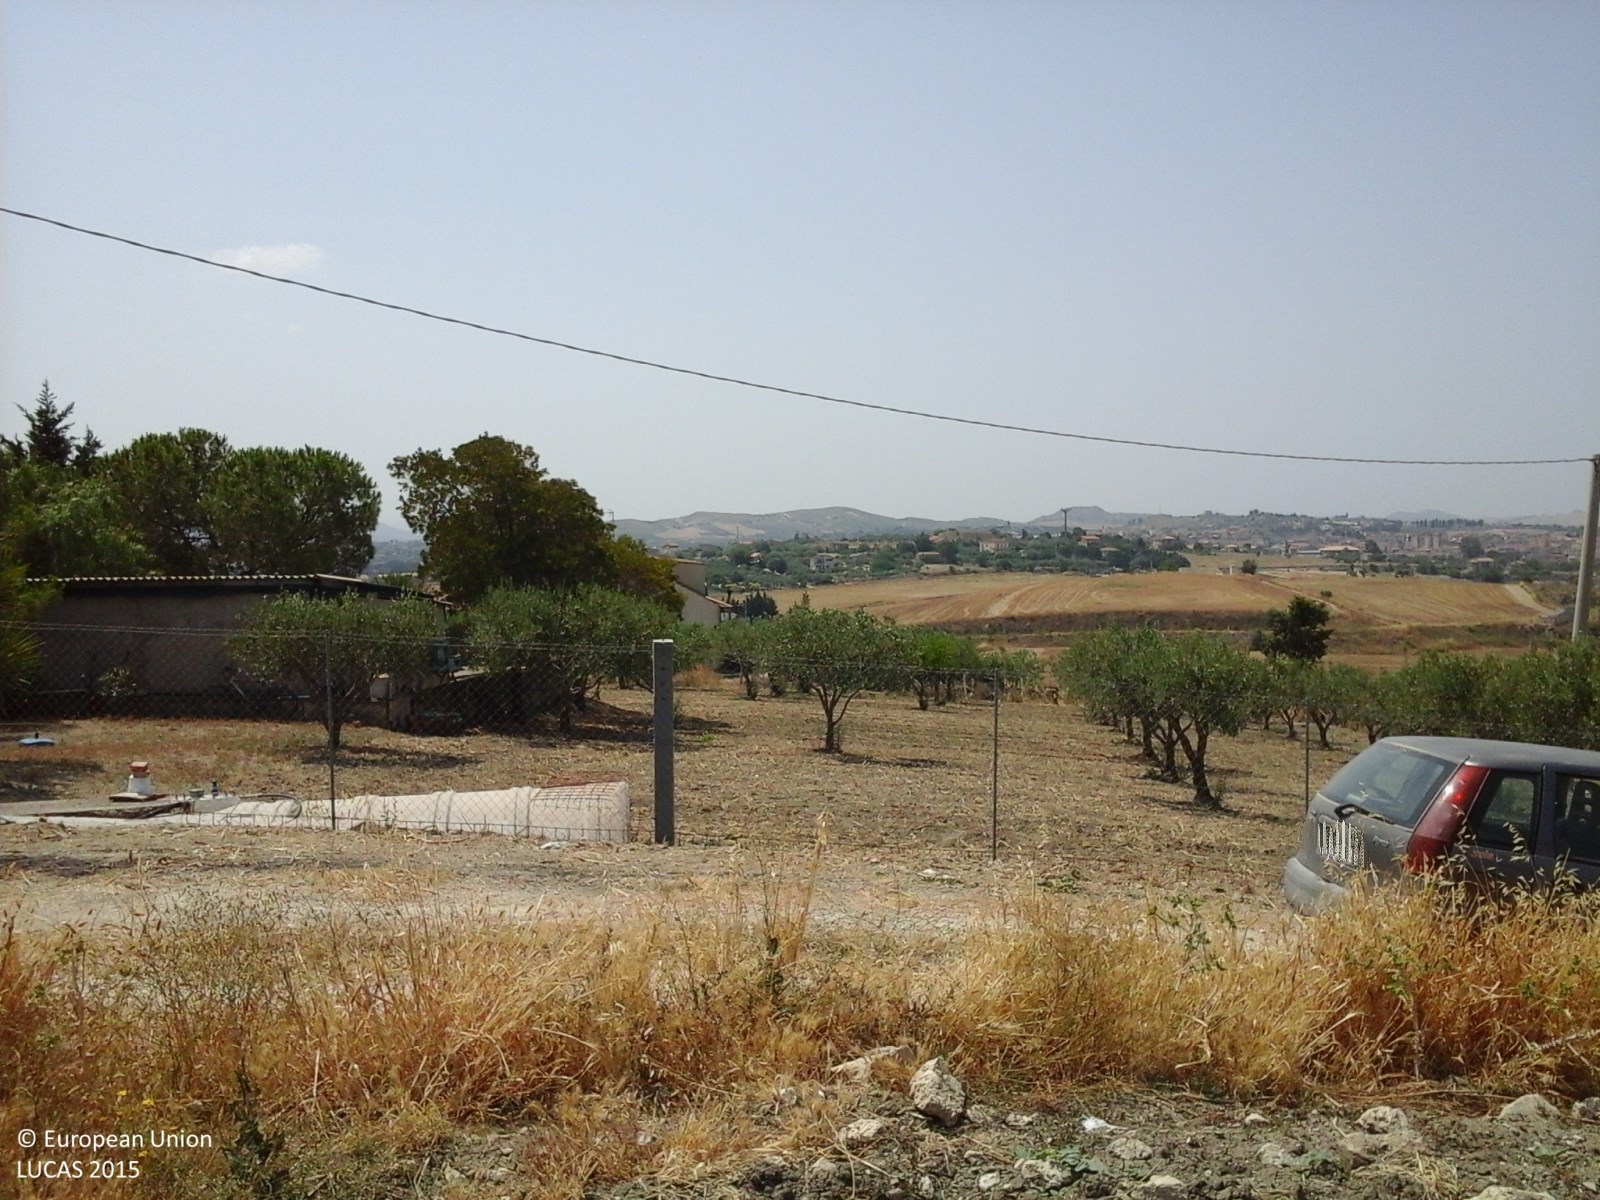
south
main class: Cropland
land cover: Arable land (only in case pi)
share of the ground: > 75 %
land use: Agriculture (excluding fallow land and kitchen gardens)
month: July
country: IT
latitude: 37.3544
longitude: 13.9998
